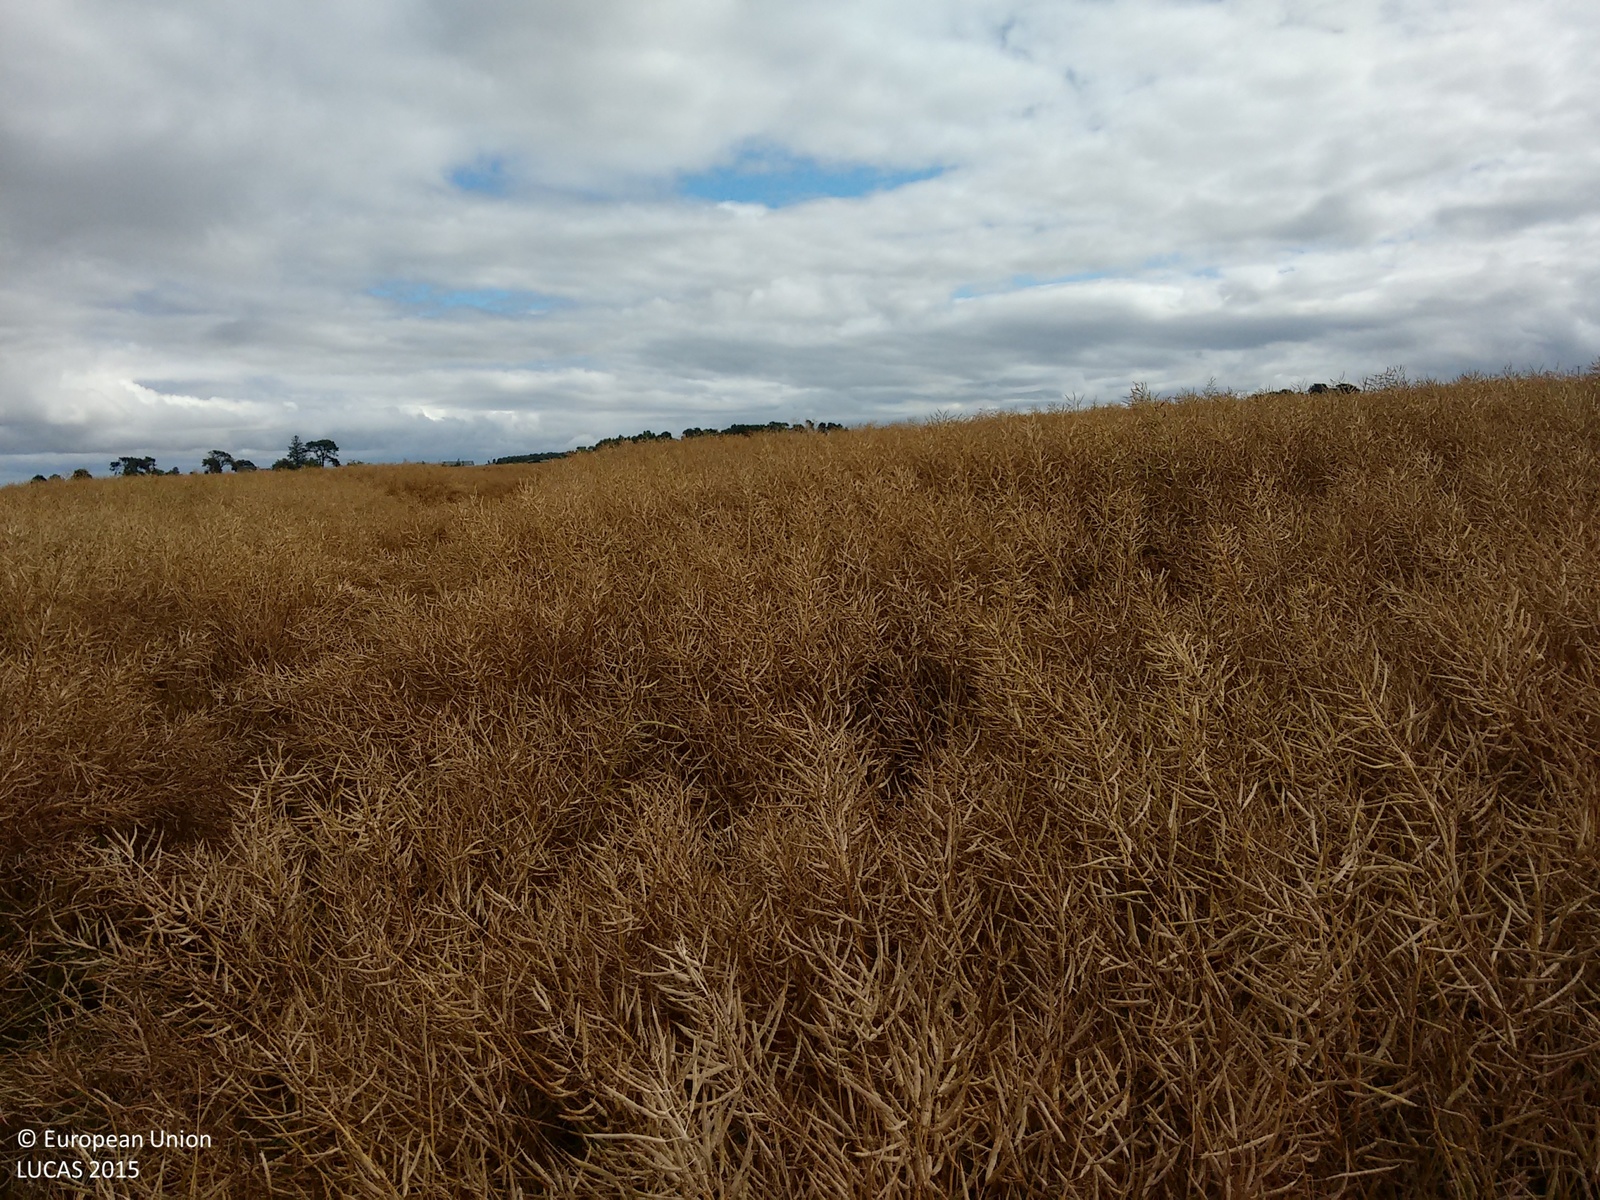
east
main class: Cropland
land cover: Rape and turnip rape
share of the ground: > 75 %
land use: Agriculture (excluding fallow land and kitchen gardens)
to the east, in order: Rape and turnip rape; Fences; Barley; Electric lines; Barley
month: August
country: GB
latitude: 57.6565
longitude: -4.2460
